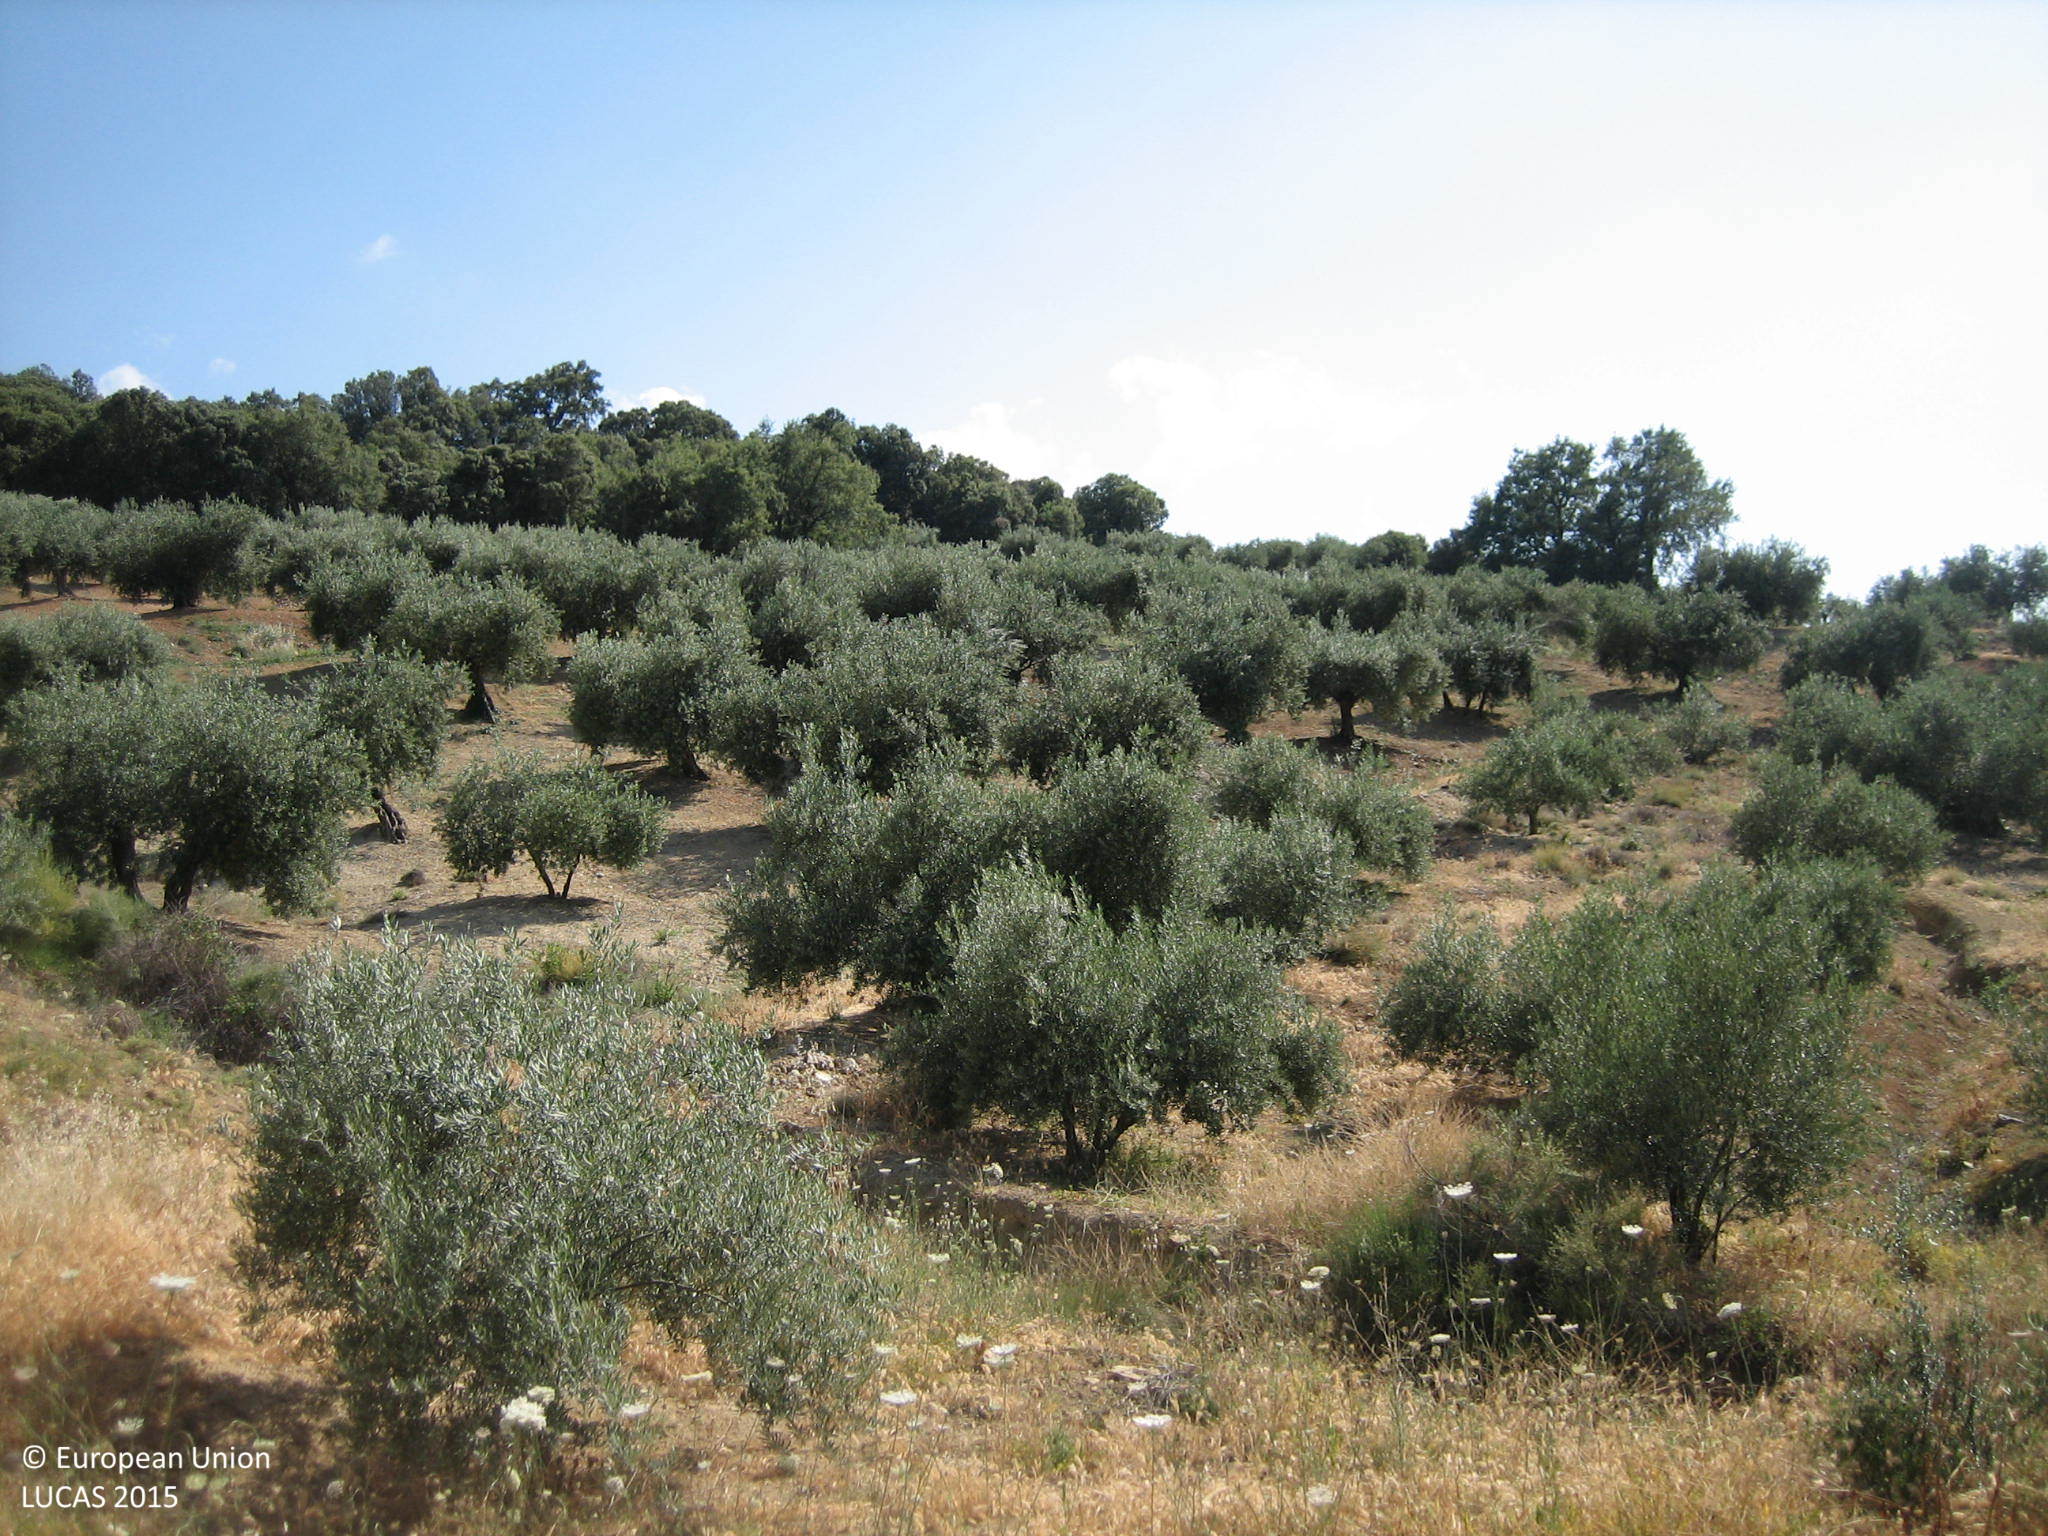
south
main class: Cropland
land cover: Olive groves
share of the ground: 10 - 25 %
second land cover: Spontaneously vegetated surfaces
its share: 10 - 25 %
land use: Agriculture (excluding fallow land and kitchen gardens)
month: June
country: ES
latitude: 37.5986
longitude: -3.8050
